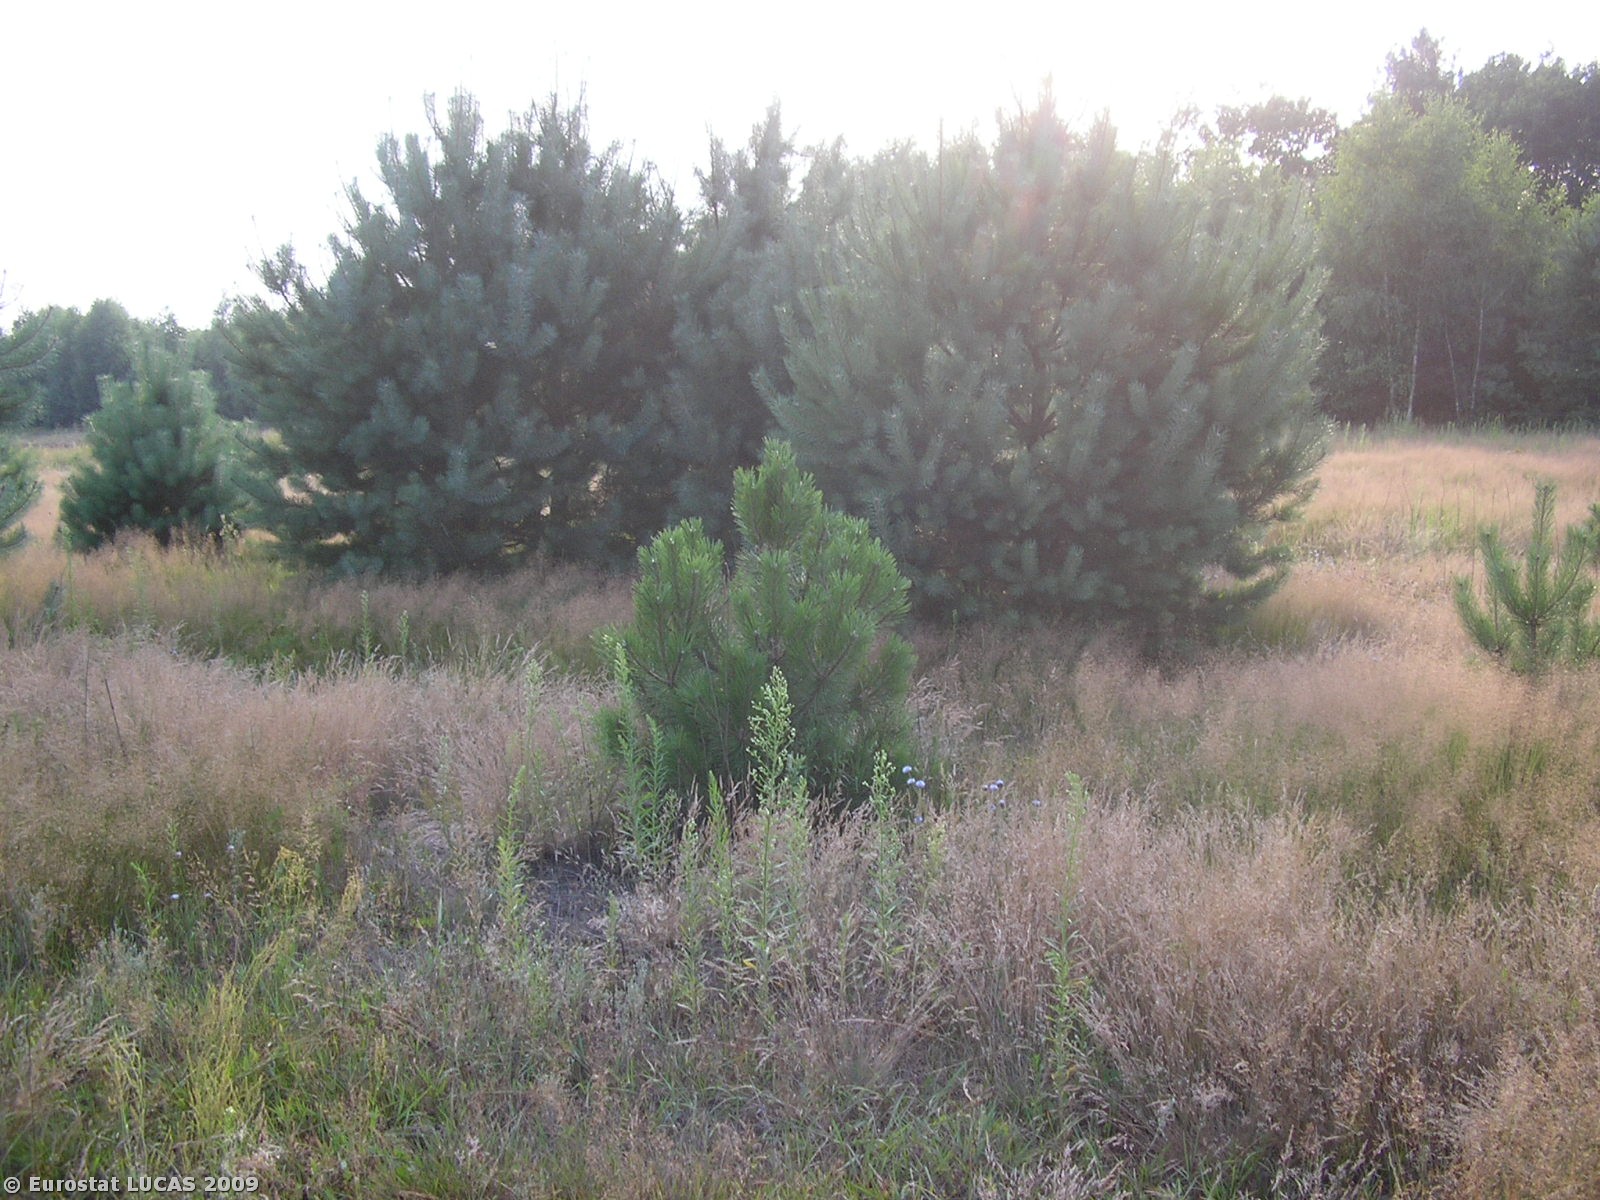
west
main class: Grassland
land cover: Grassland with sparse tree/shrub cover
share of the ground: > 75 %
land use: Unused
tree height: < 5 m
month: July
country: PL
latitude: 52.1066
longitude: 22.2242
